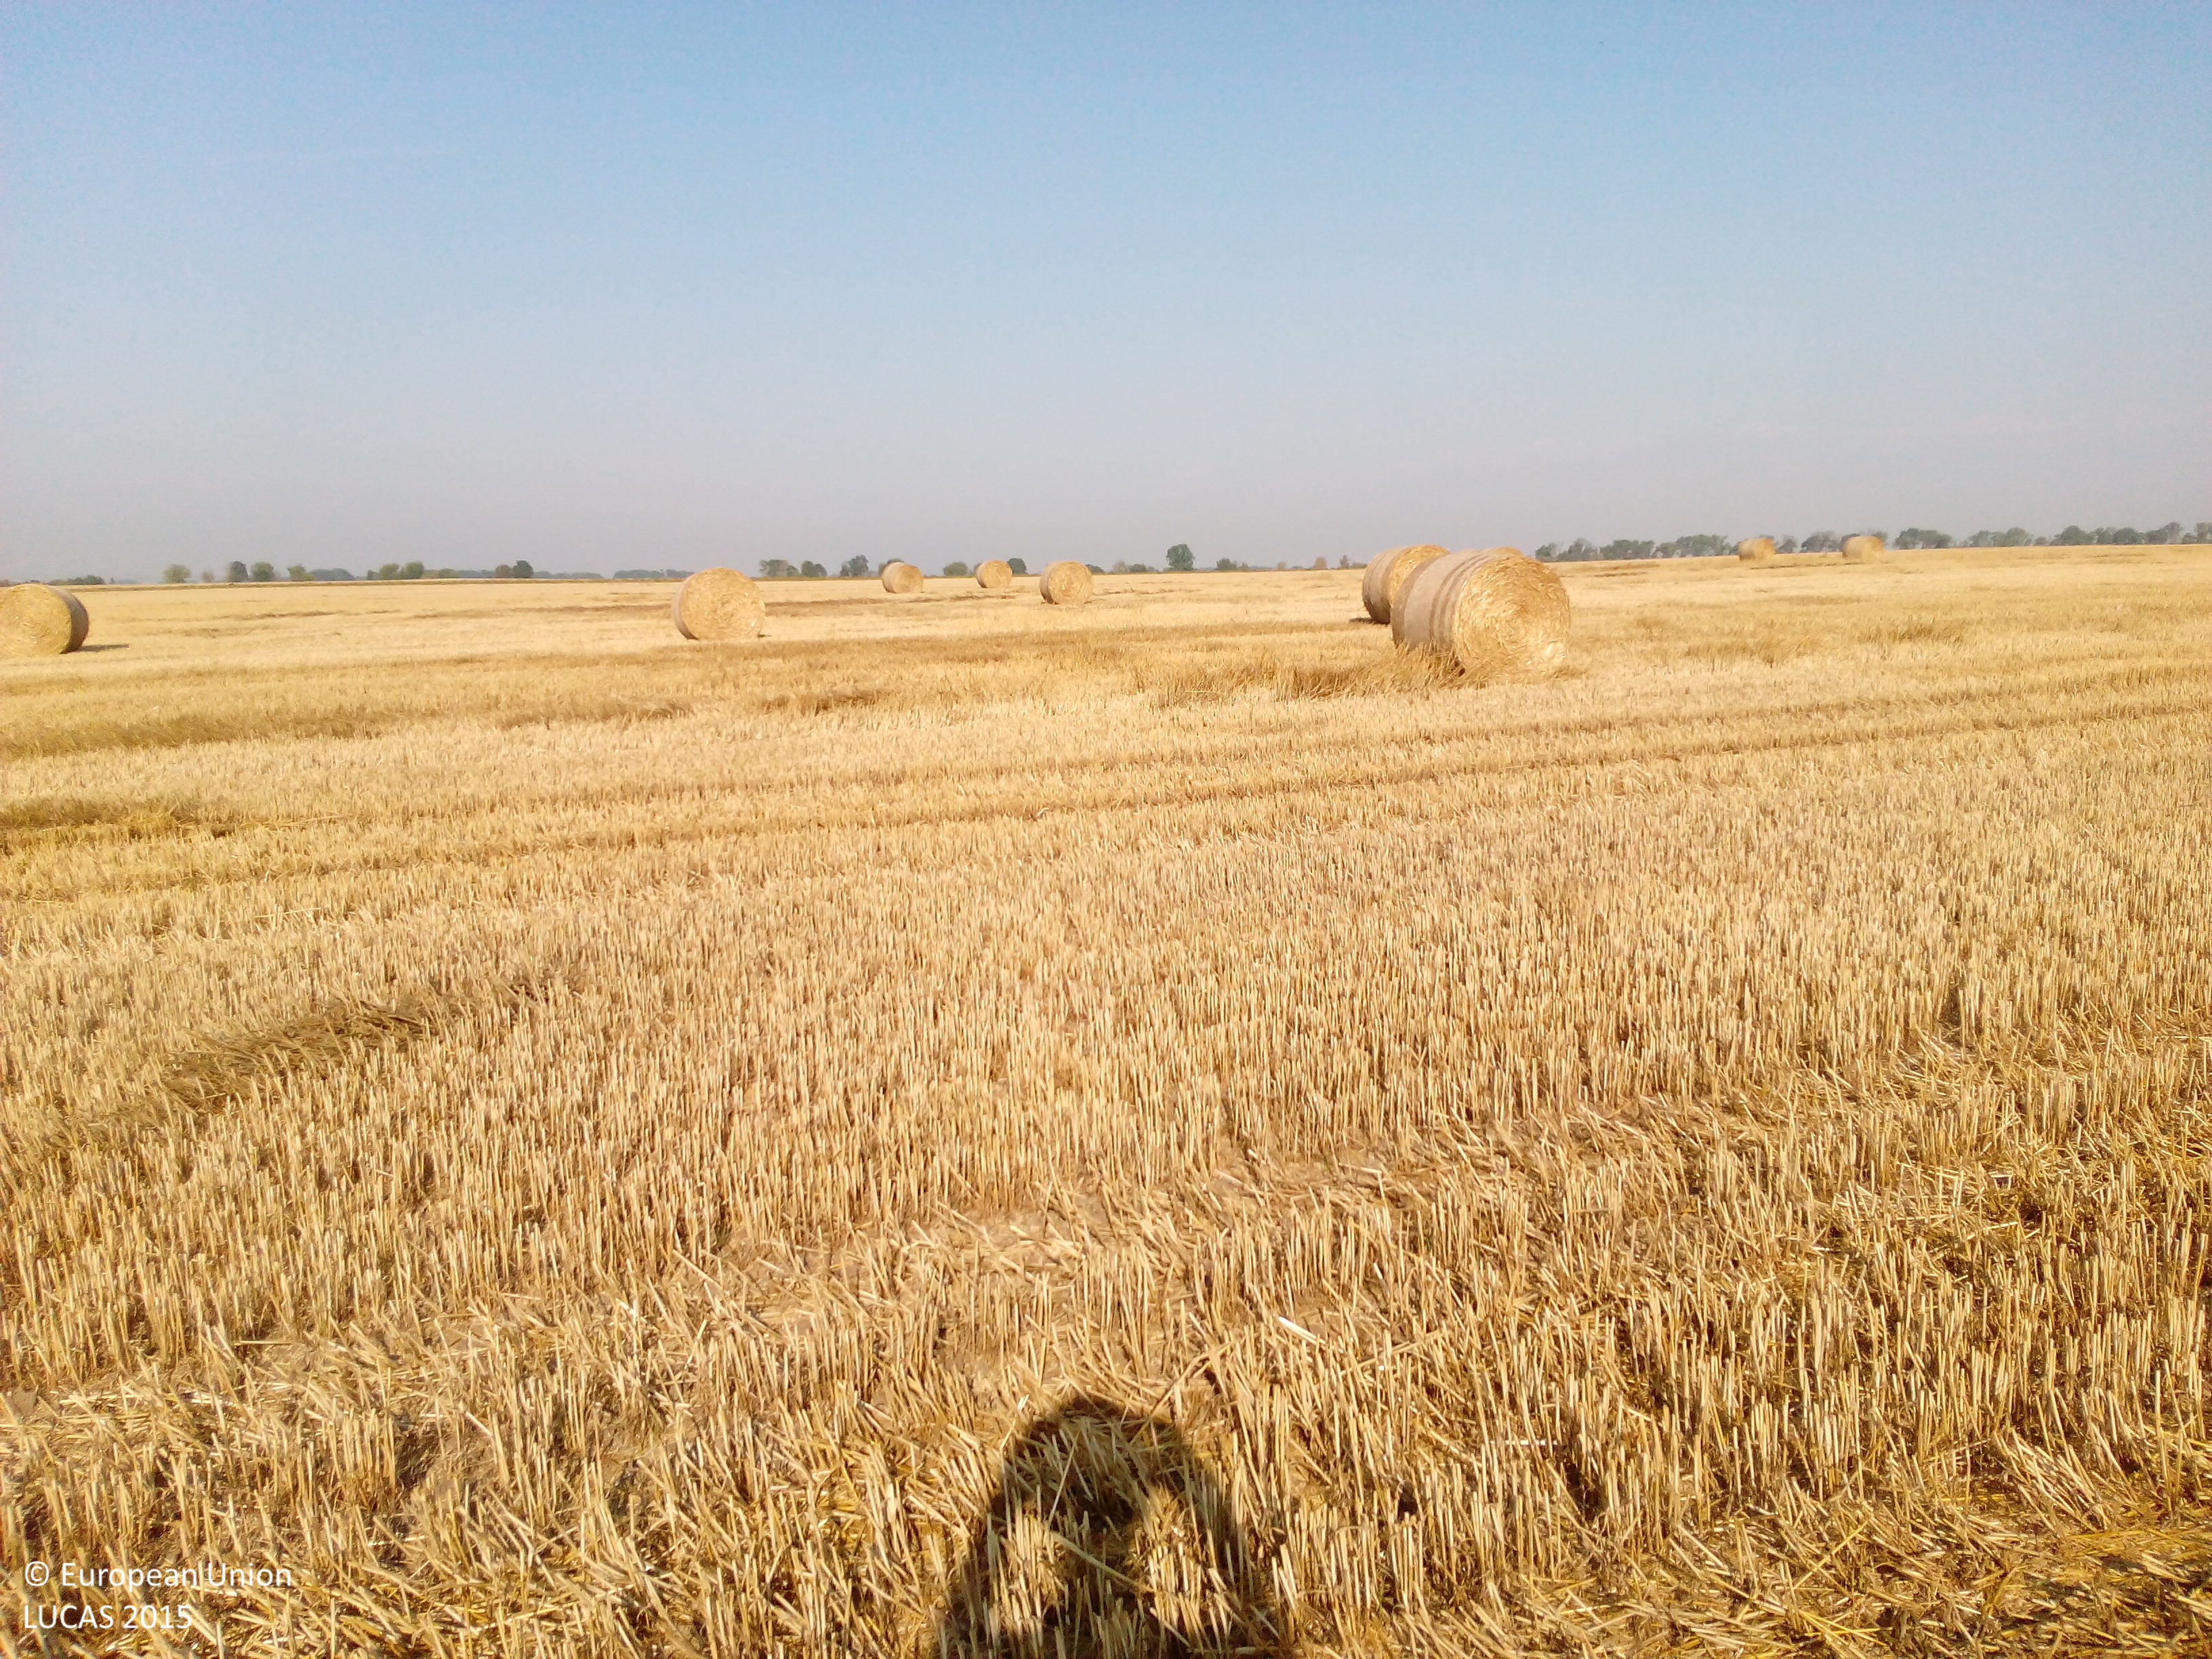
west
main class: Cropland
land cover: Common wheat
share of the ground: > 75 %
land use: Agriculture (excluding fallow land and kitchen gardens)
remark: Harvested field
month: August
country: DE
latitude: 52.0486
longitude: 11.1224
